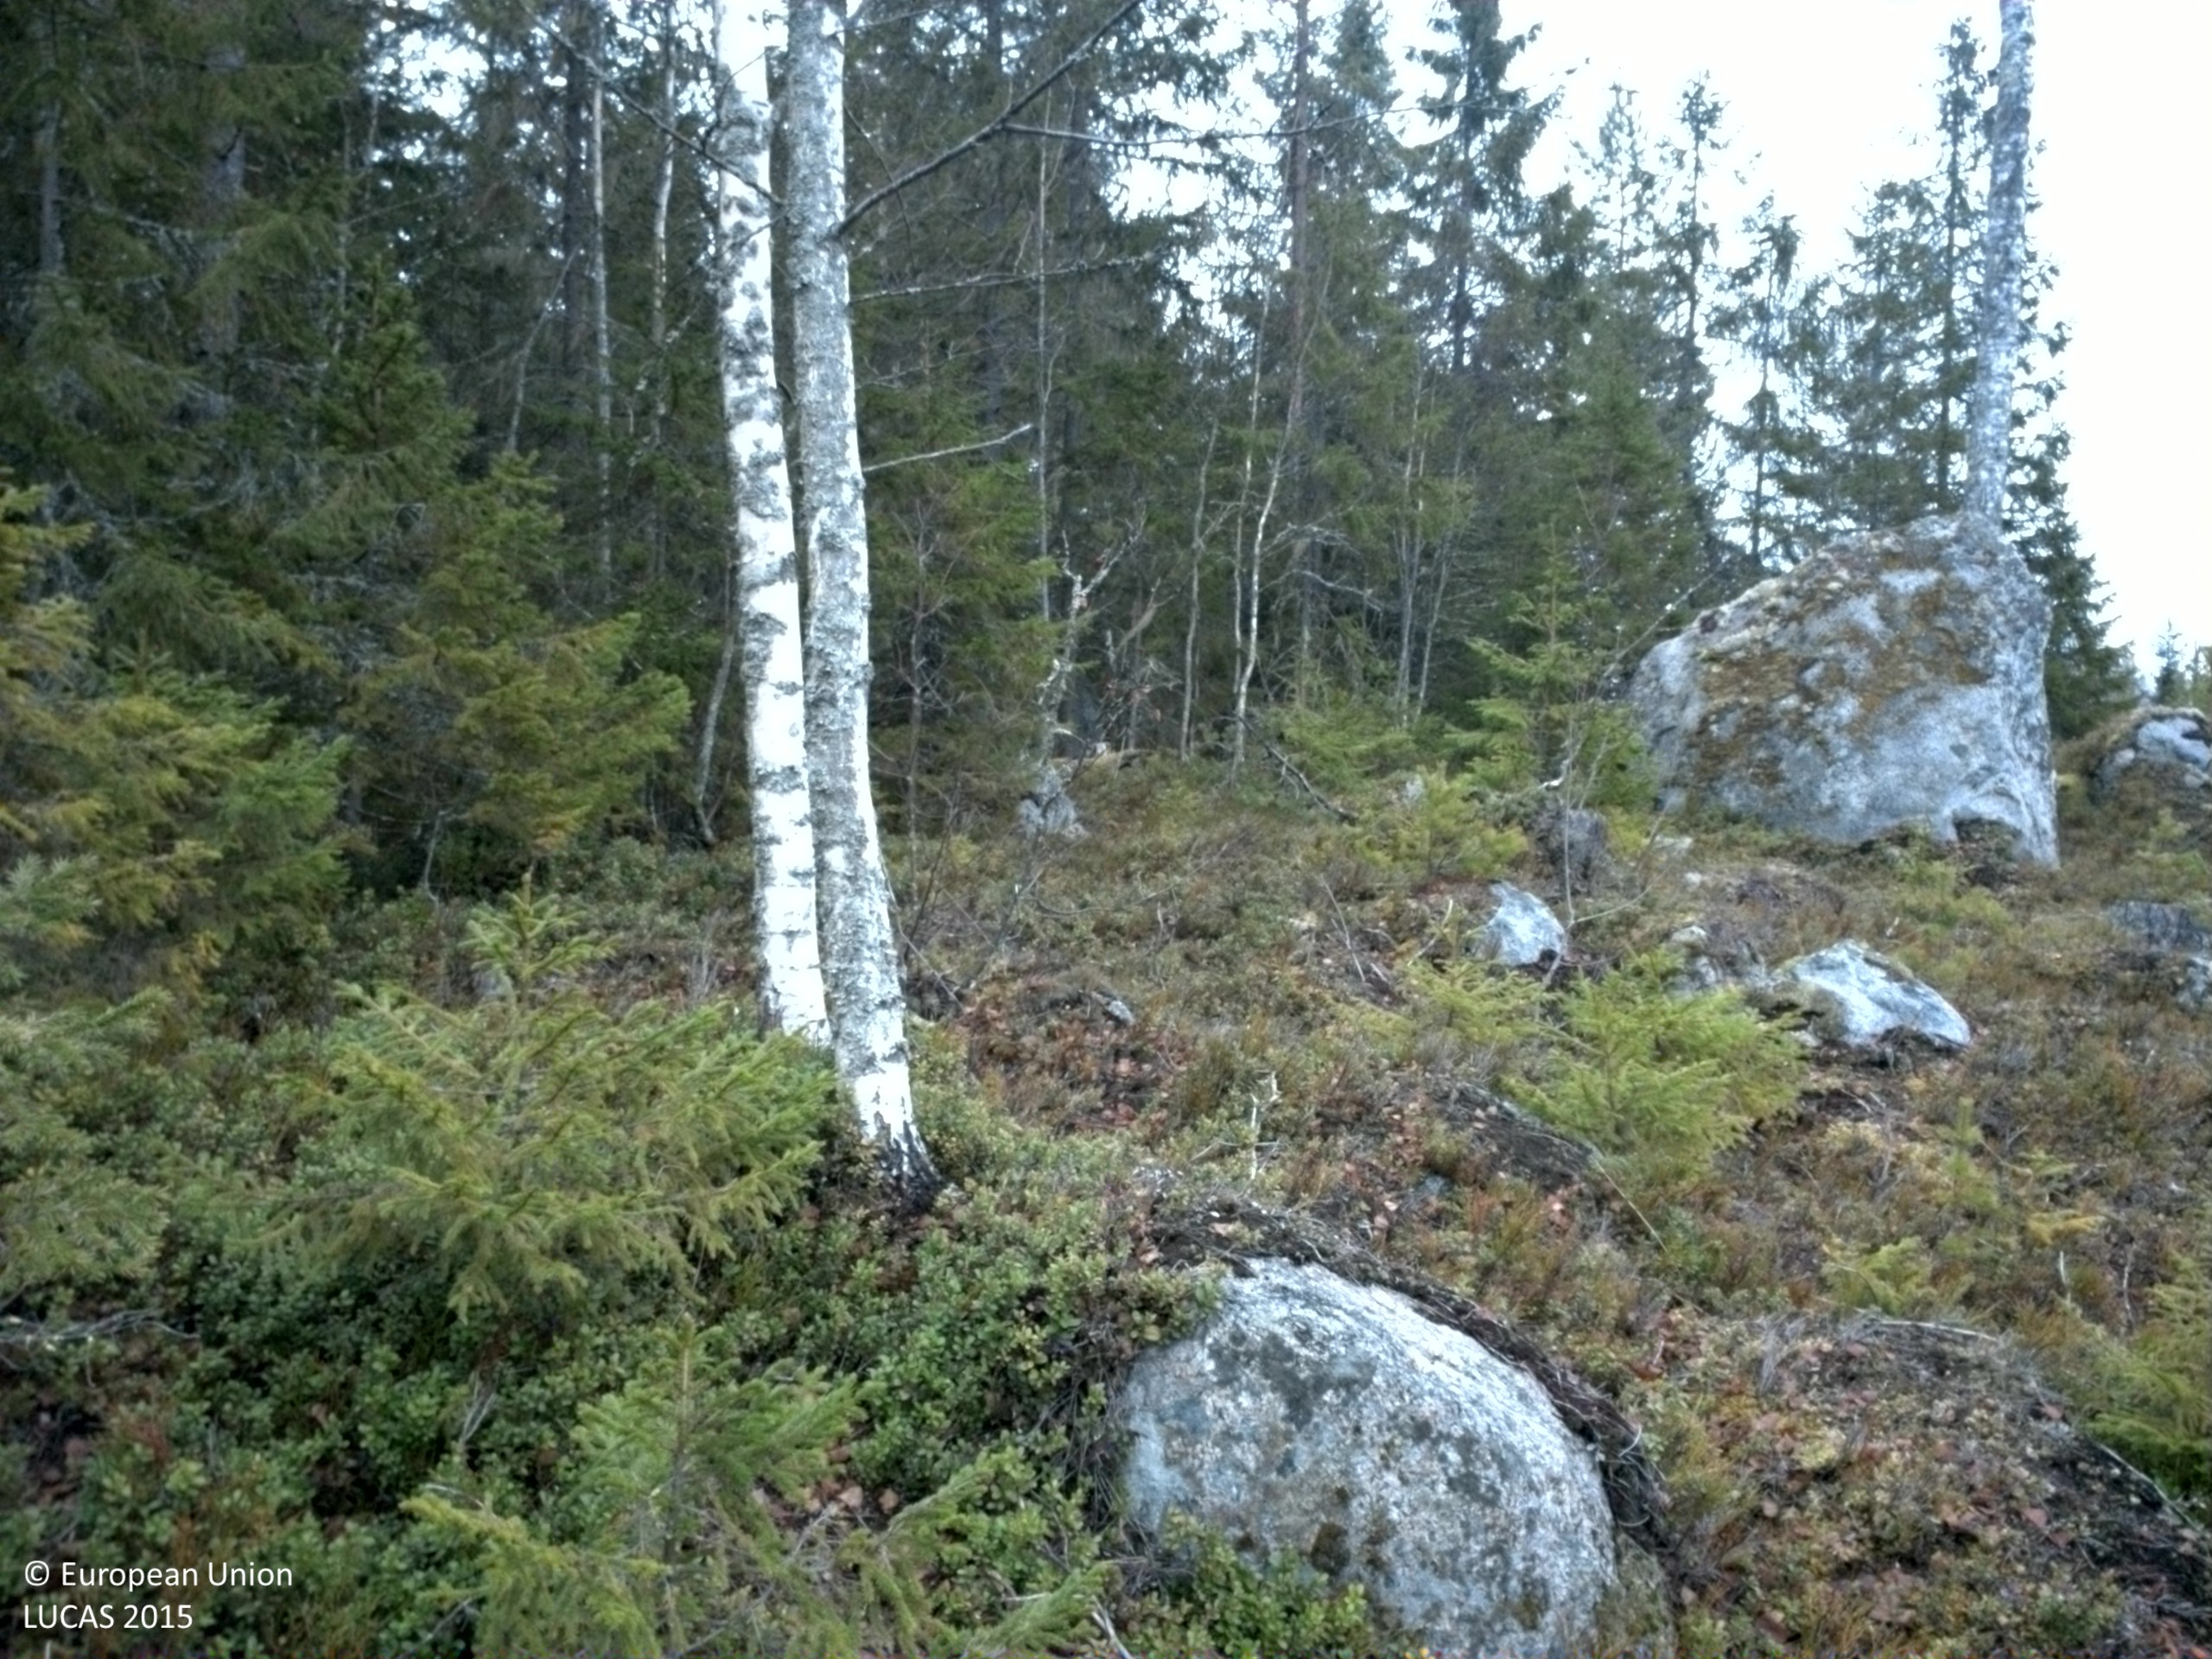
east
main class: Woodland
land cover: Other mixed woodland
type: boreal forest
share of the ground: 25 - 50 %
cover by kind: shrubs 35 %, coniferous forest trees 25 %, lichens and mosses 20 %, broadleaved forest trees 10 %, herbaceous plants 5 %, consolidated bare surface 5 %
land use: Forestry
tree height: < 5 m
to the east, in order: Other mixed woodland; Spruce dominated coniferous woodland; Spruce dominated mixed woodland; Tracks; Spruce dominated mixed woodland; Spruce dominated coniferous woodland; Rivers and streams; Spruce dominated coniferous woodland; Pine dominated coniferous woodland; Spruce dominated mixed woodland; Ditches and canals; Spruce dominated mixed woodland
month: November
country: SE
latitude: 61.5819
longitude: 16.9725
